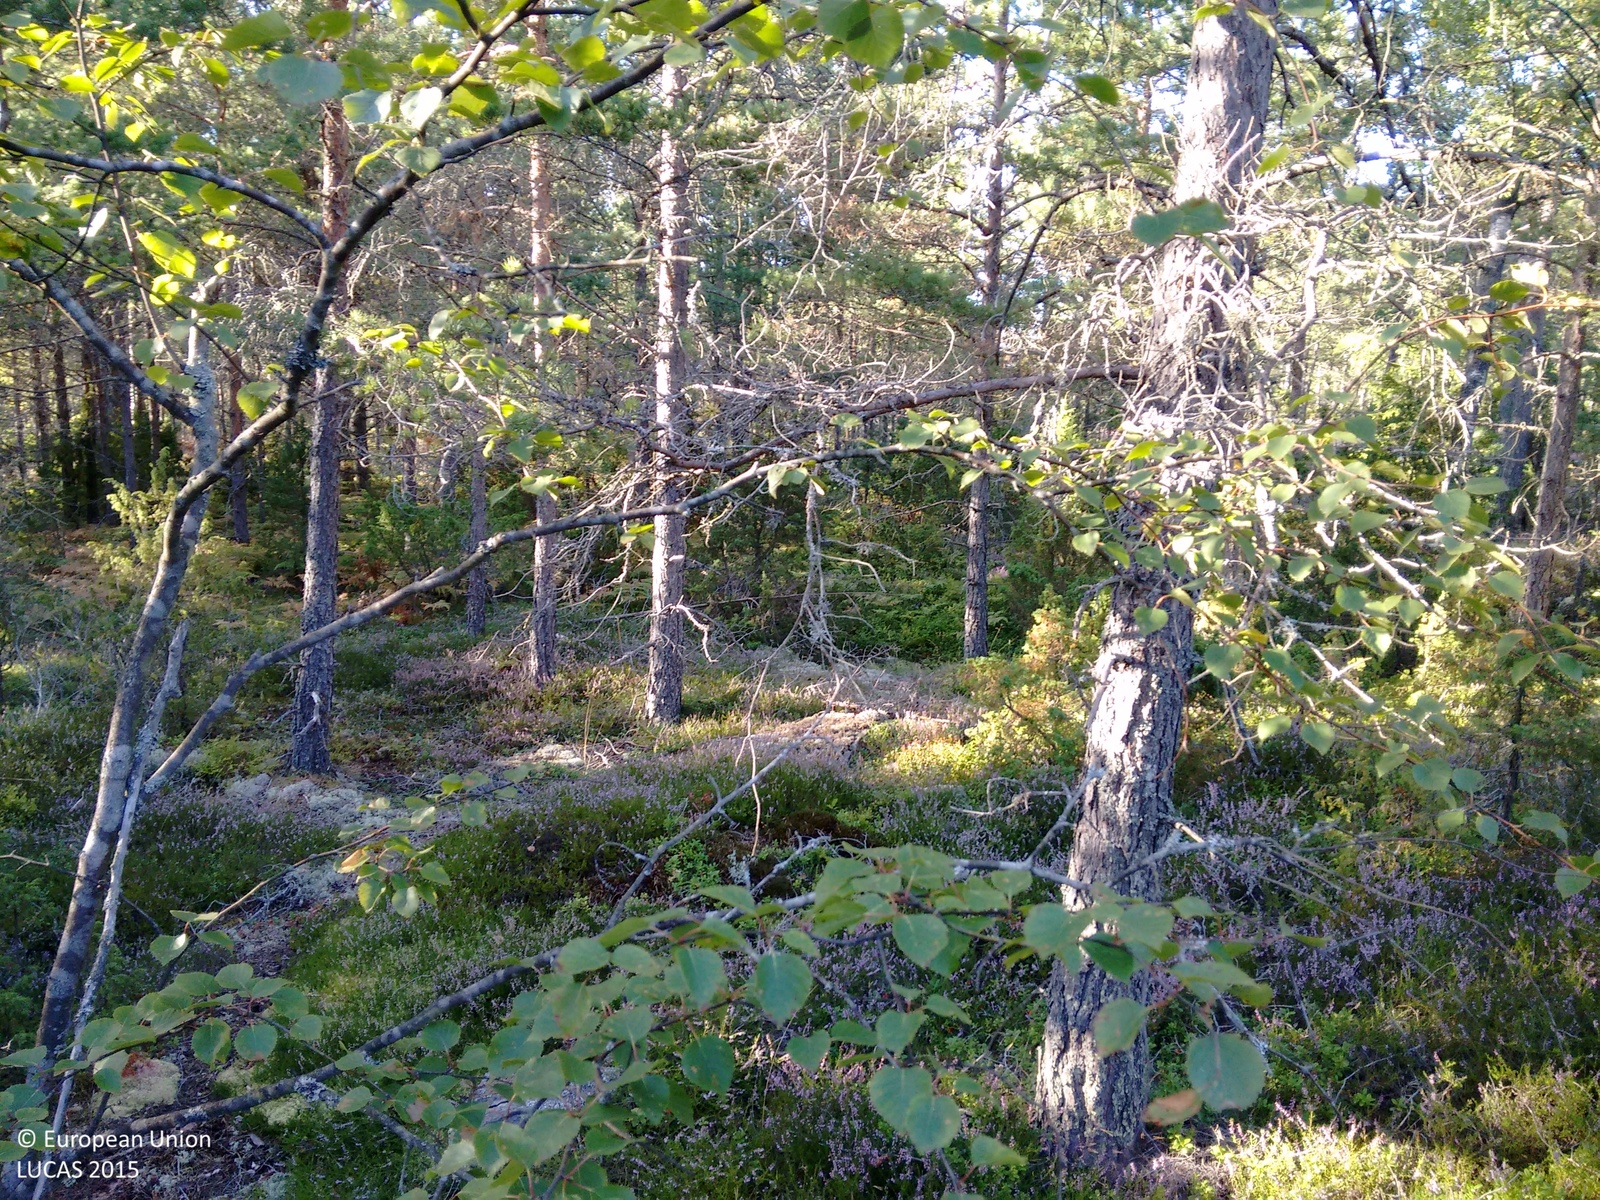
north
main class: Woodland
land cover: Pine dominated coniferous woodland
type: hemiboreal forest and nemoral coniferous forest and mixed broadleaved-coniferous forest
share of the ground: > 75 %
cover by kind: coniferous forest trees 70 %, broadleaved forest trees 15 %, lichens and mosses 10 %, unconsolidated bare surface 5 %
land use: Amenities, museums, leisure
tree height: > 5 m
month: August
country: FI
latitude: 60.1741
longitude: 19.9382
